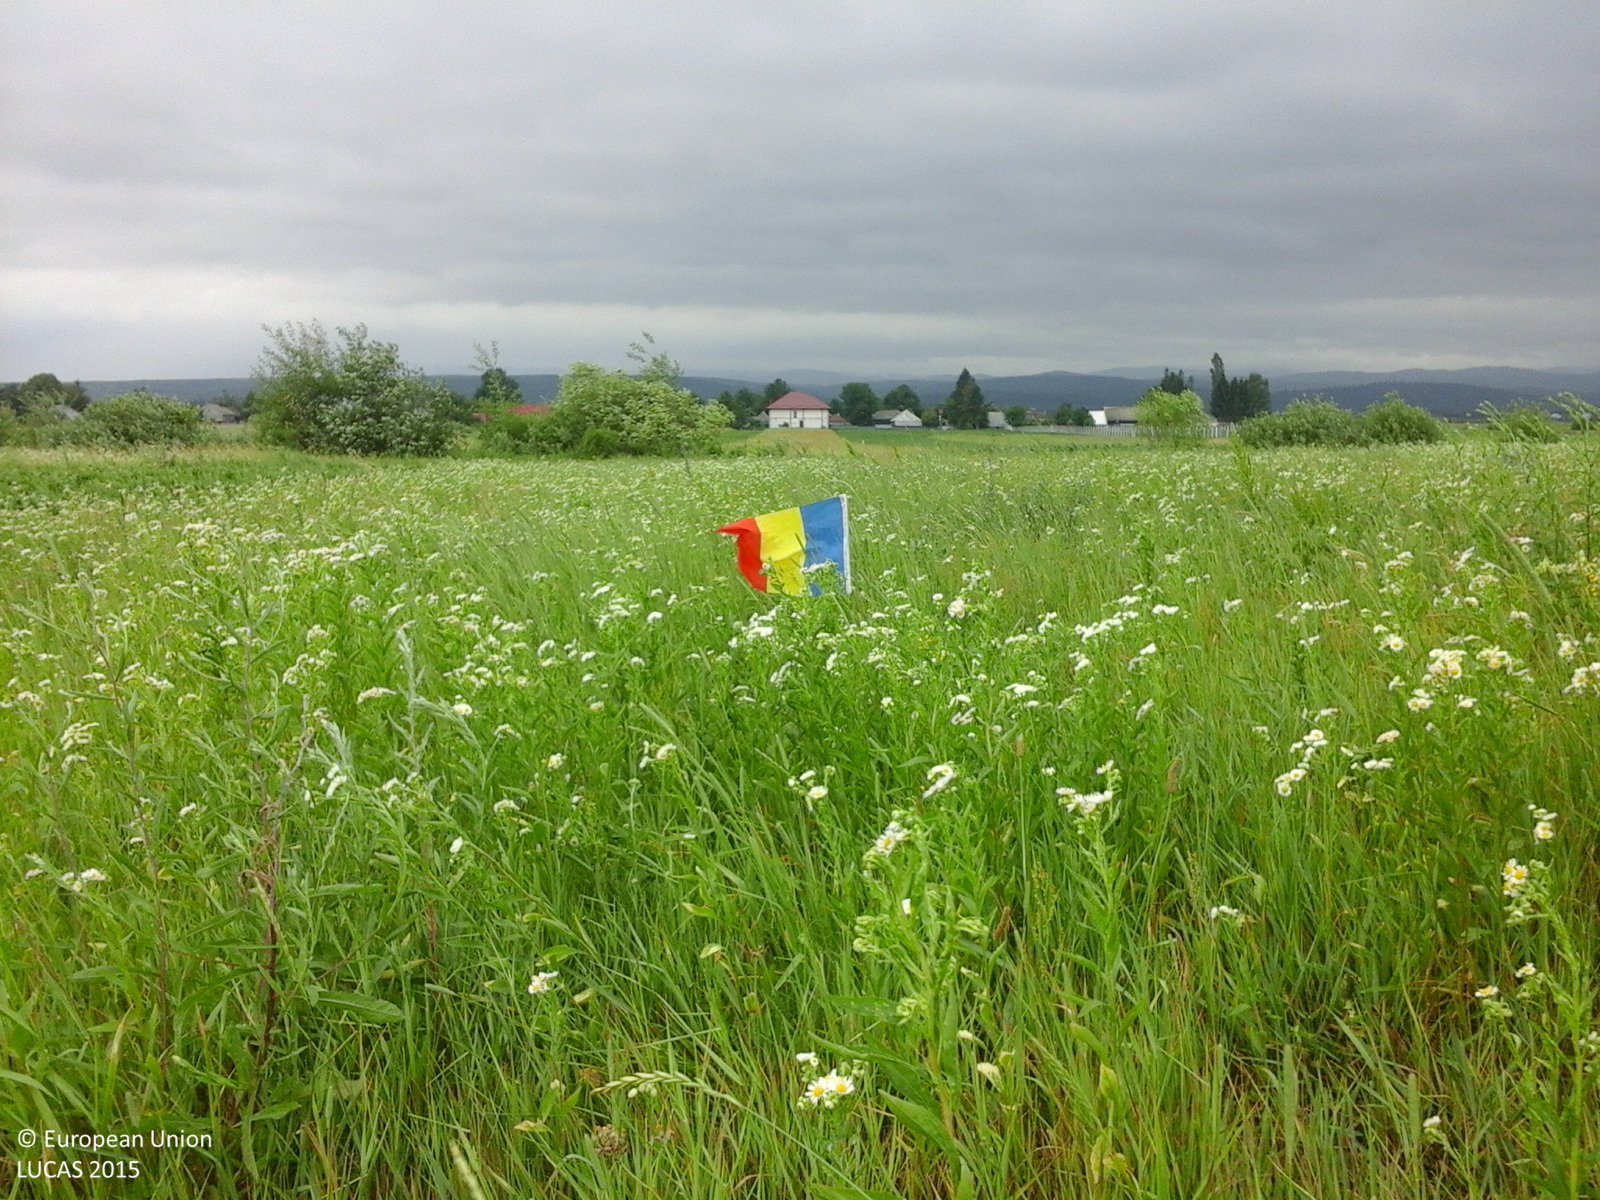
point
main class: Grassland
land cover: Grassland without tree/shrub cover
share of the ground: > 75 %
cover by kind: herbaceous plants 100 %
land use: Agriculture (excluding fallow land and kitchen gardens)
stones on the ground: < 10 %
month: June
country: RO
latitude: 47.4264
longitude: 26.2686
